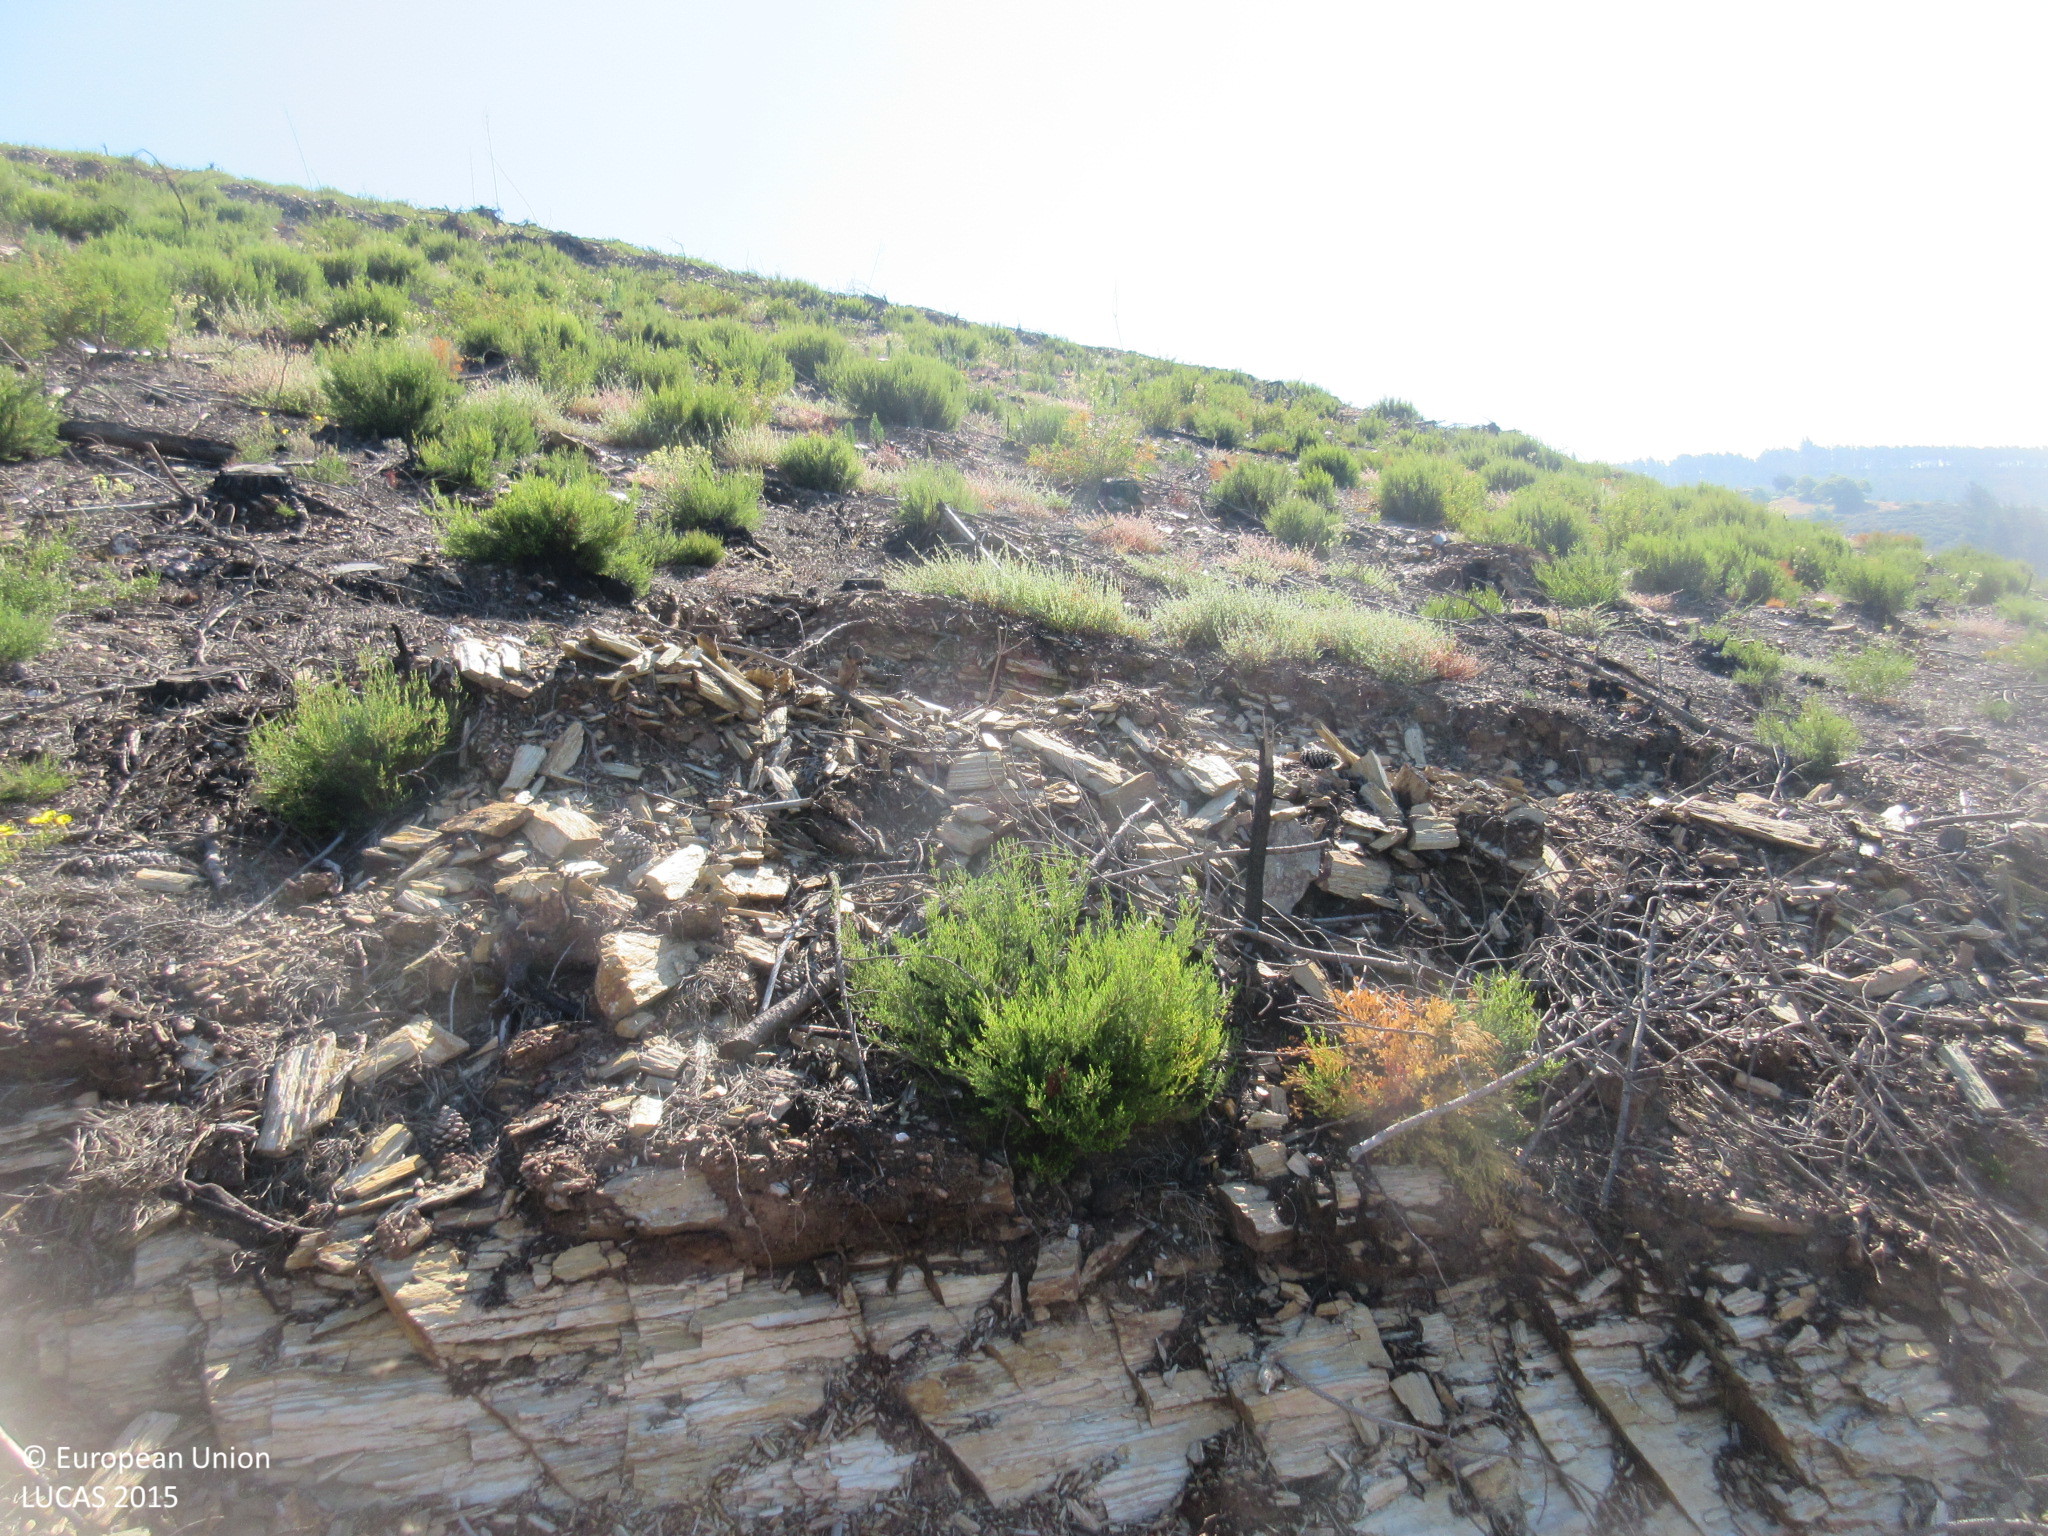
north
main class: Shrubland
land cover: Shrubland without tree cover
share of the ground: 50 - 75 %
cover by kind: shrubs 65 %, unconsolidated bare surface 35 %
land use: Forestry
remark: Clear cut
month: June
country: ES
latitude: 43.0822
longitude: -7.0015
